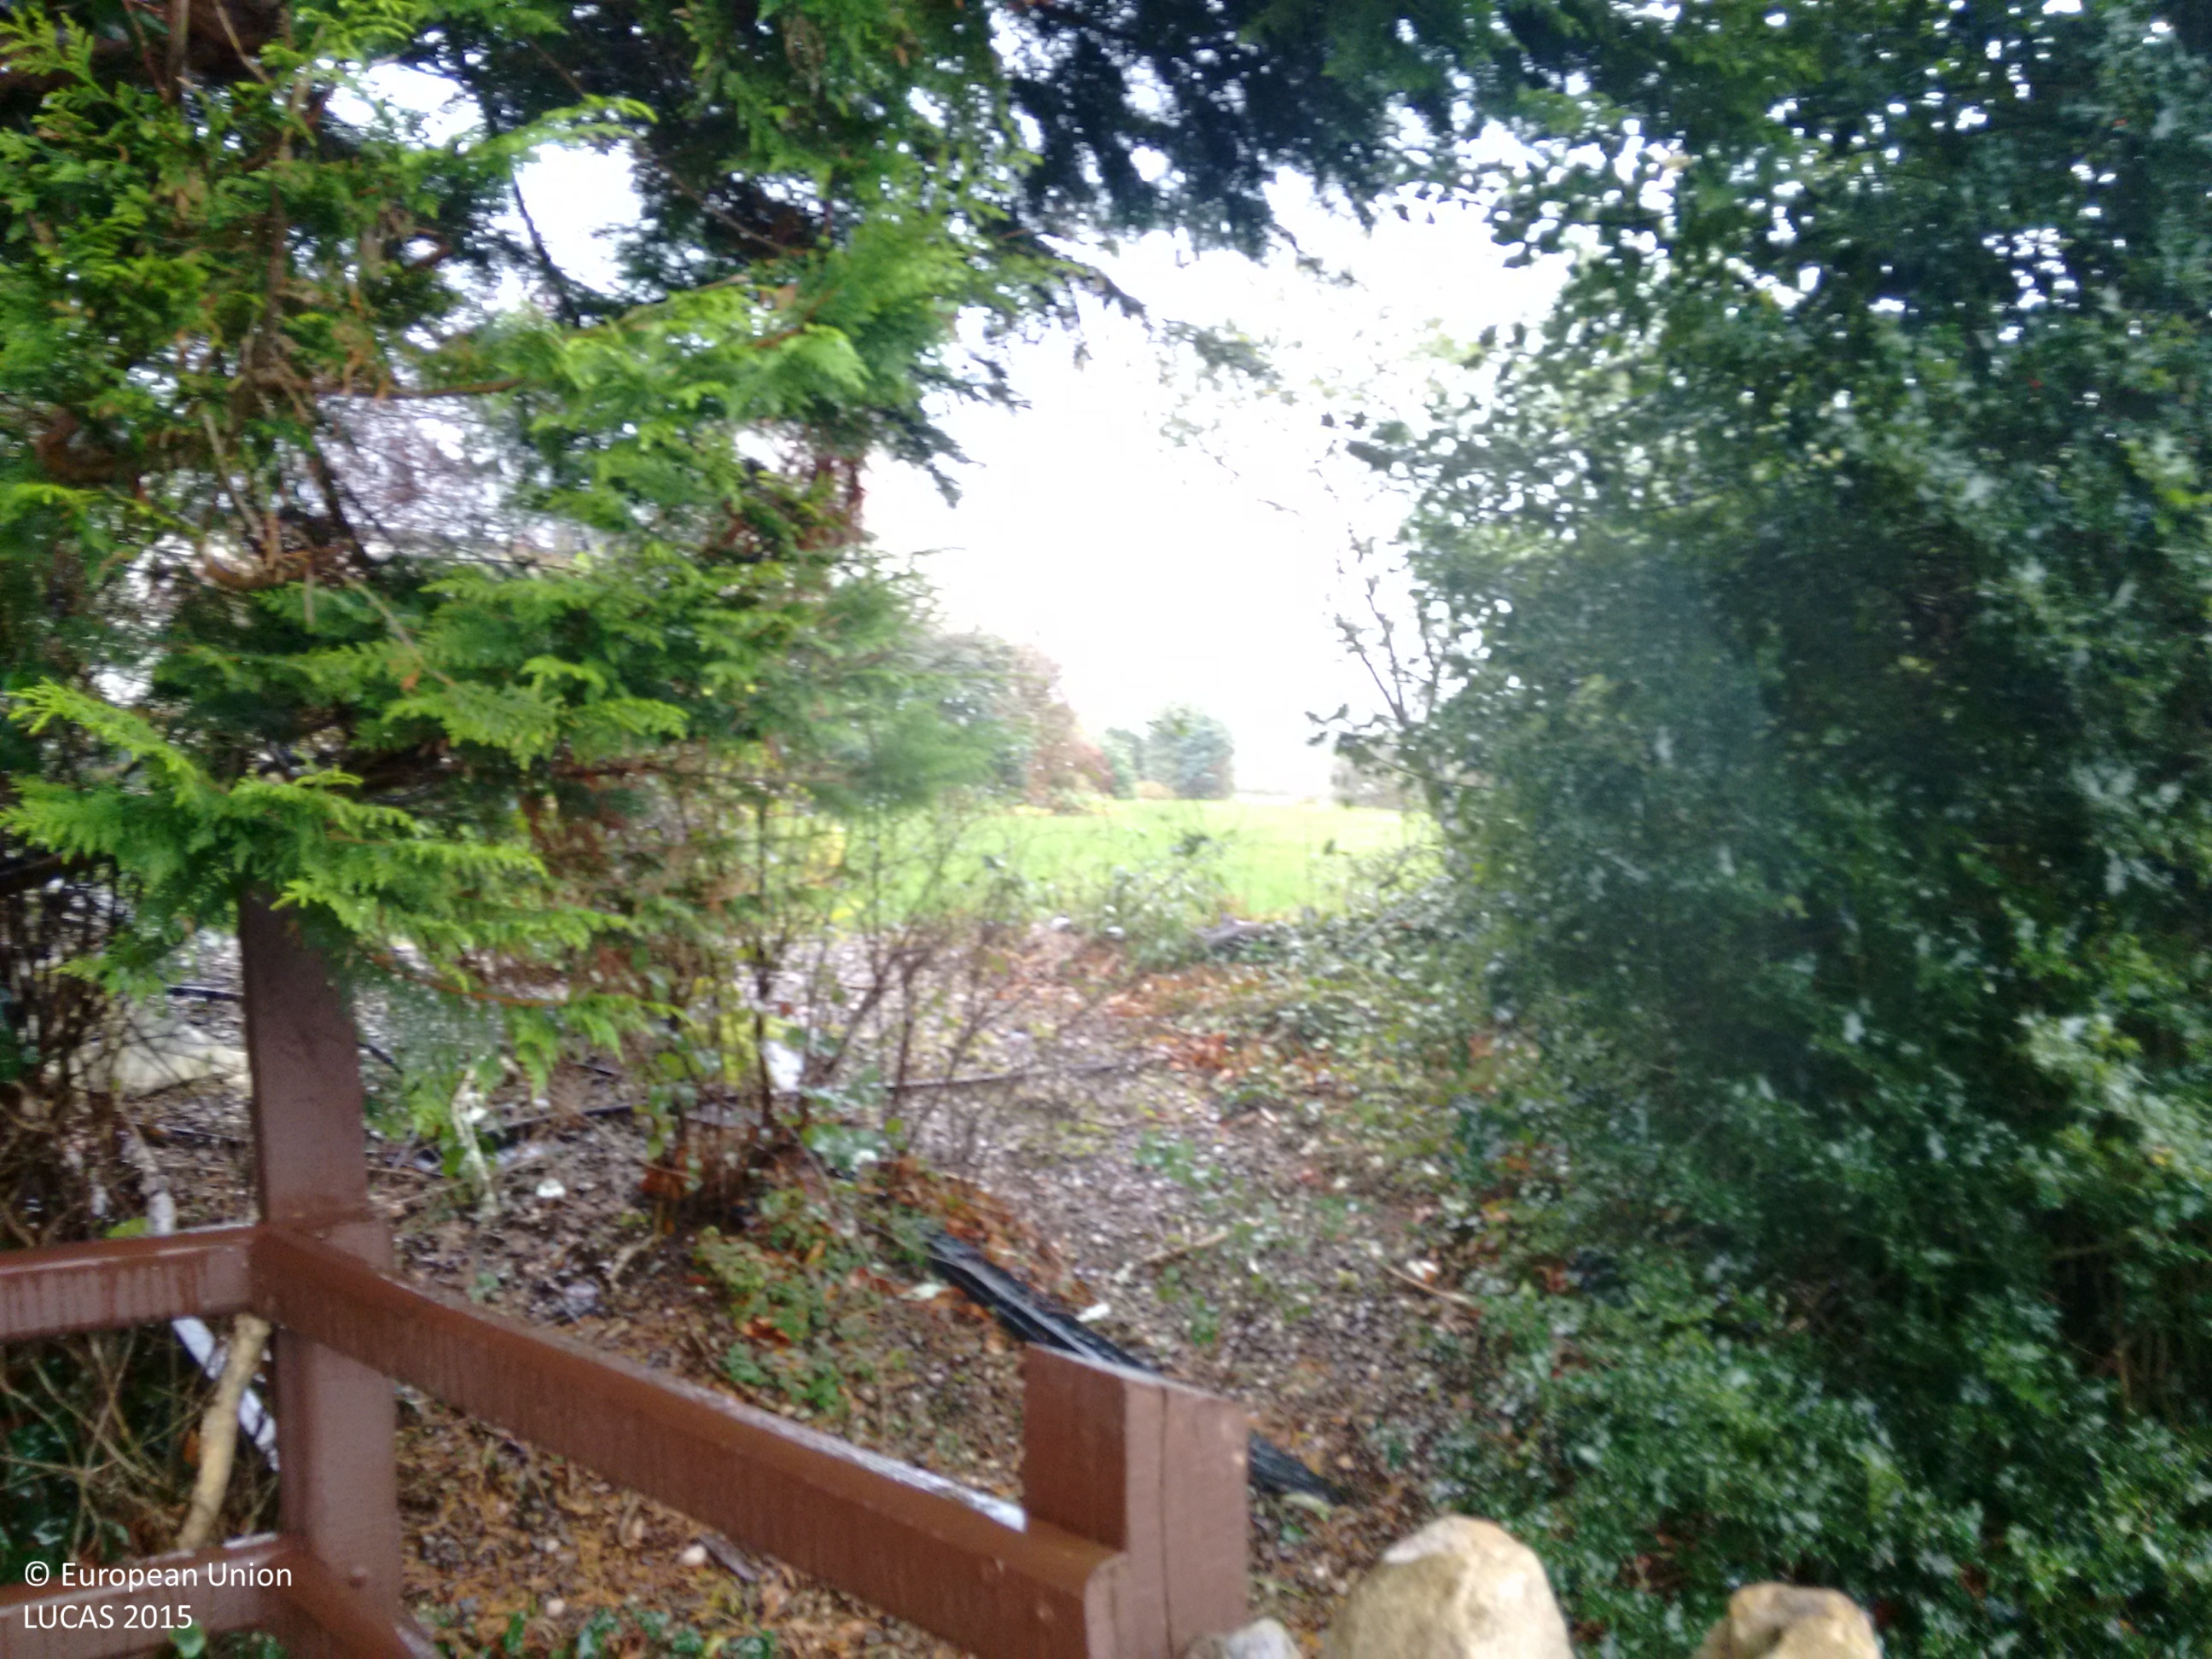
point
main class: Grassland
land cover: Grassland without tree/shrub cover
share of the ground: > 75 %
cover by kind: herbaceous plants 100 %
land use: Residential
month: November
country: IE
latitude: 54.5251
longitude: -8.1475
